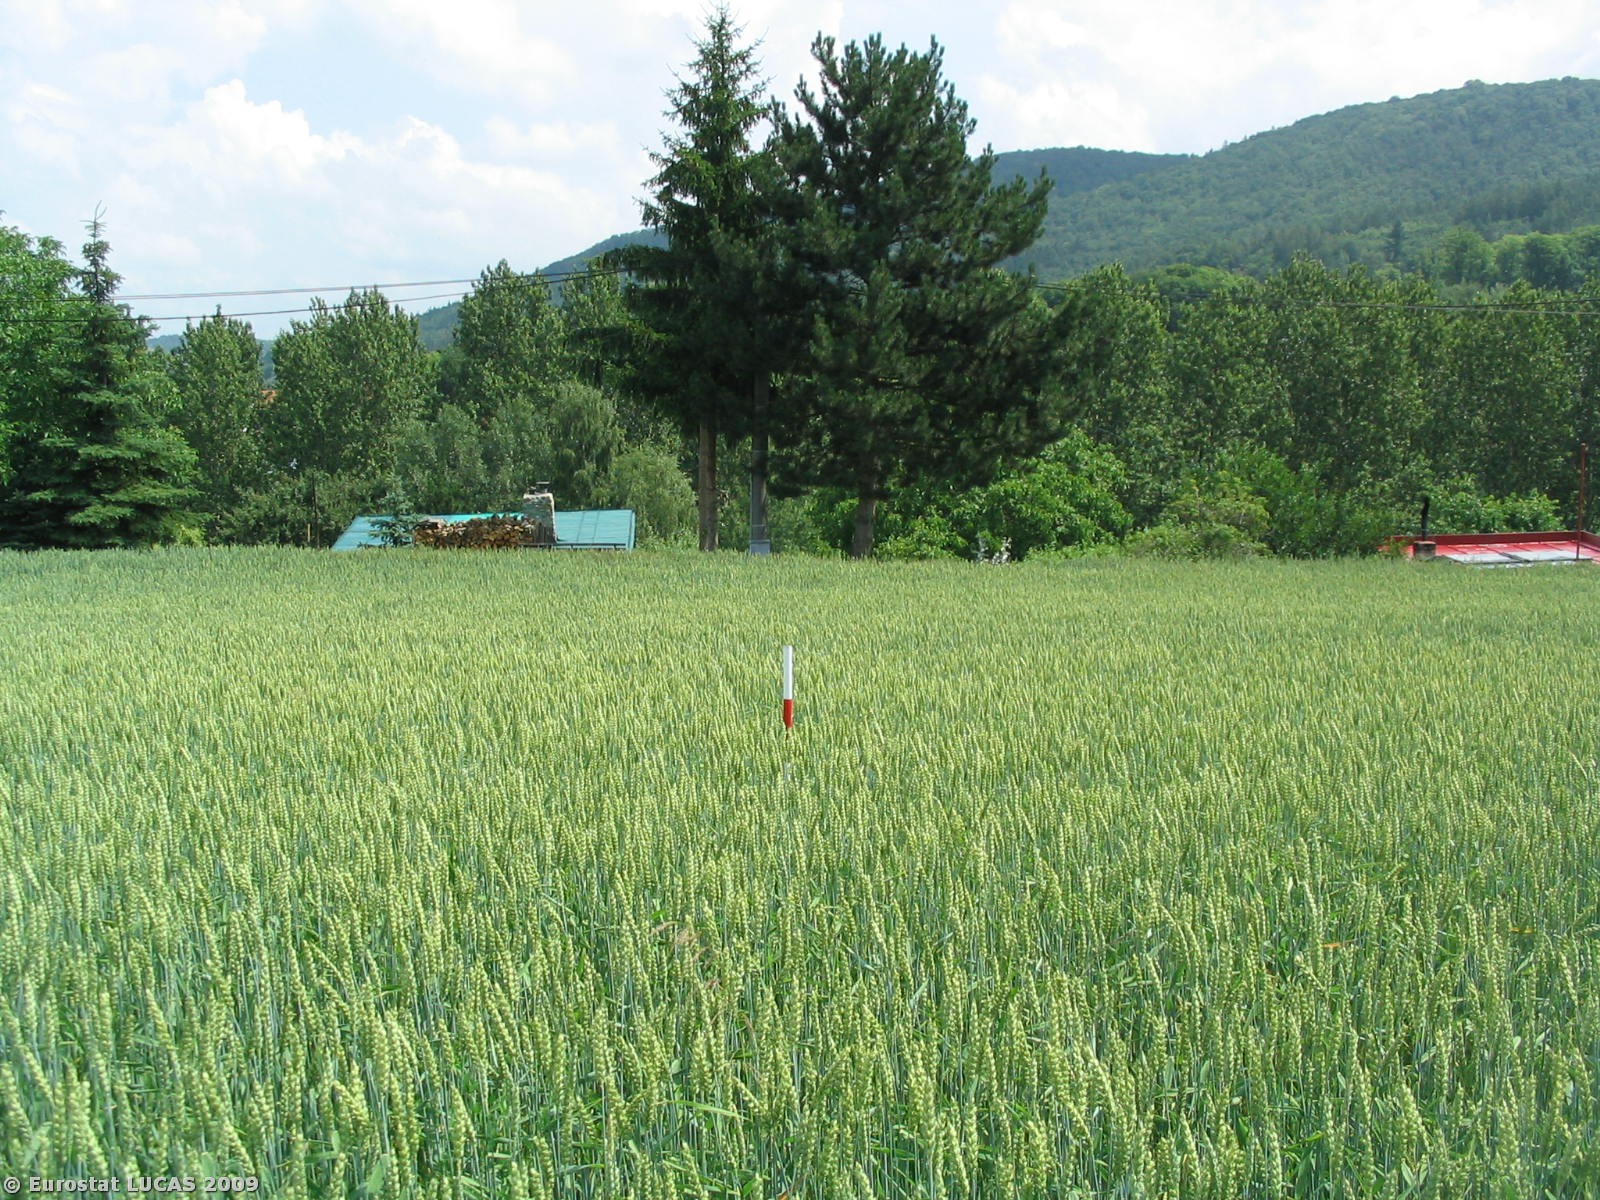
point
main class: Cropland
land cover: Common wheat
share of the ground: > 75 %
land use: Agriculture (excluding fallow land and kitchen gardens)
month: June
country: CZ
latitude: 49.2797
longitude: 16.4538
